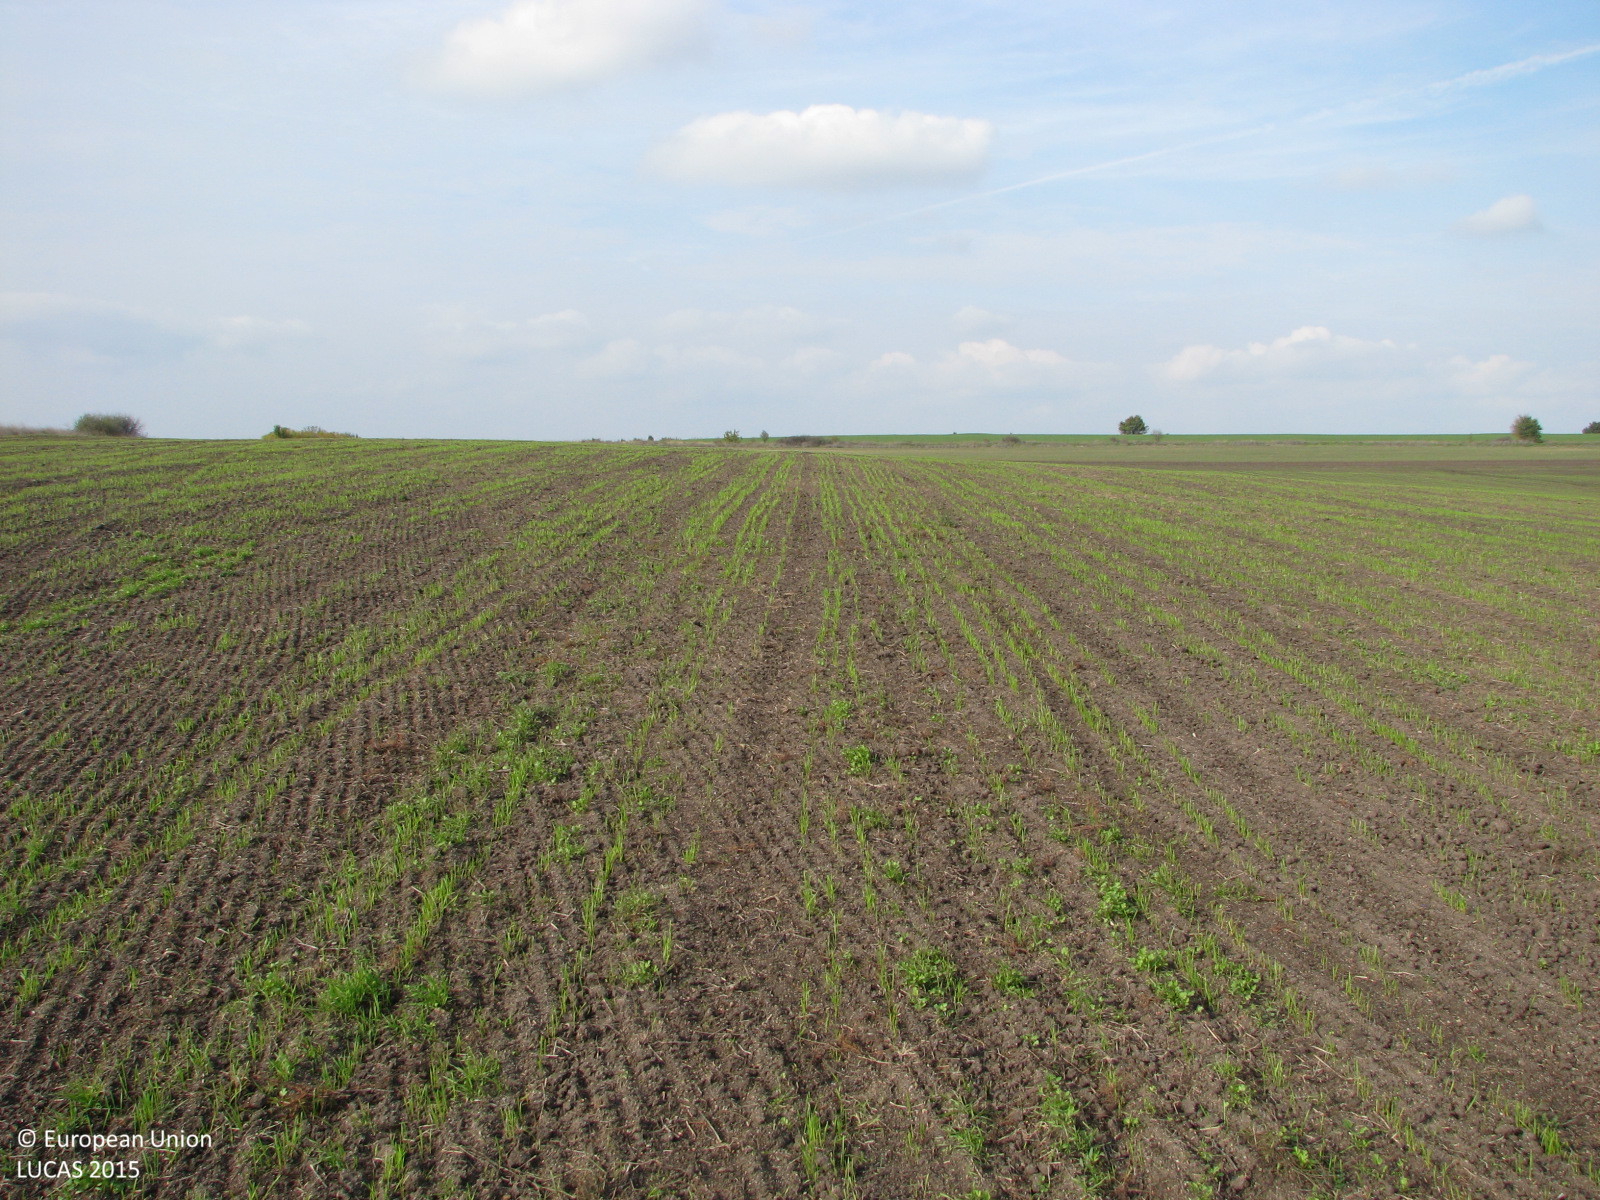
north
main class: Cropland
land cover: Common wheat
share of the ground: 10 - 25 %
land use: Agriculture (excluding fallow land and kitchen gardens)
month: October
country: BG
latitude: 42.2248
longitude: 26.6295
